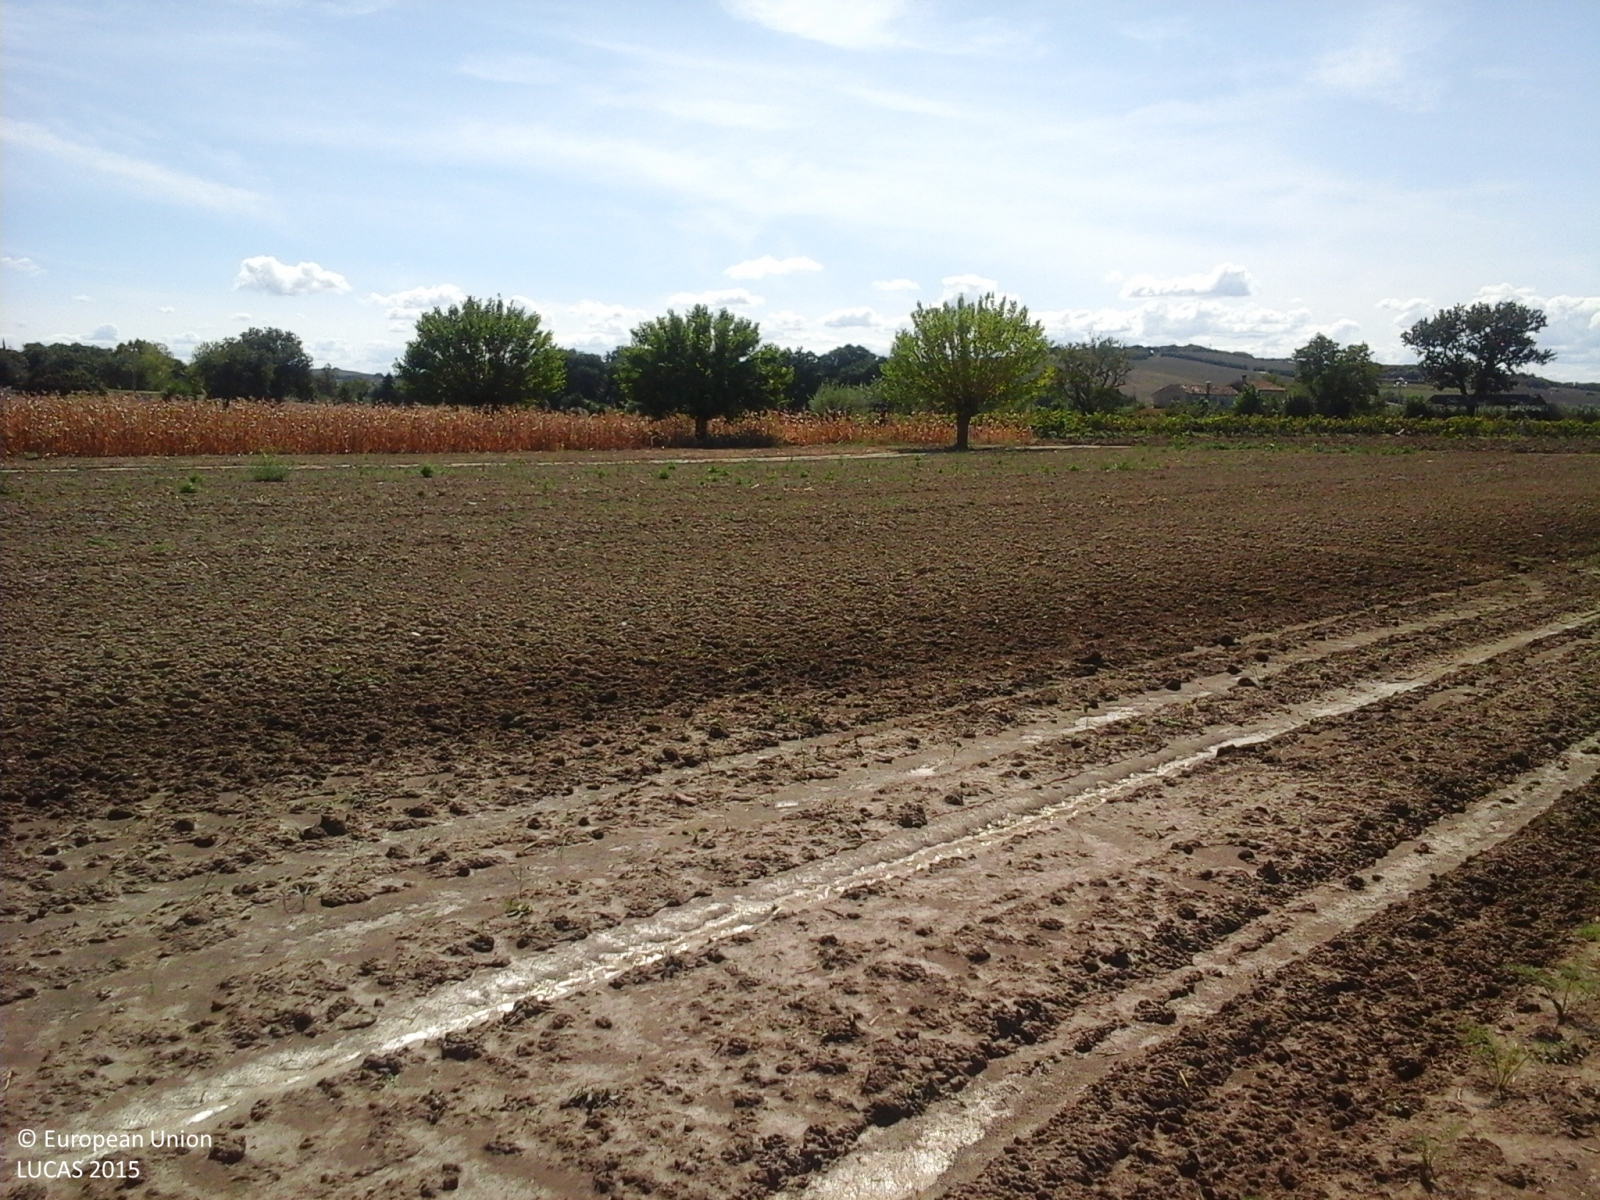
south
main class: Cropland
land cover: Other fresh vegetables
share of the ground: 10 - 25 %
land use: Agriculture (excluding fallow land and kitchen gardens)
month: September
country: IT
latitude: 43.8007
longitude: 13.0381
